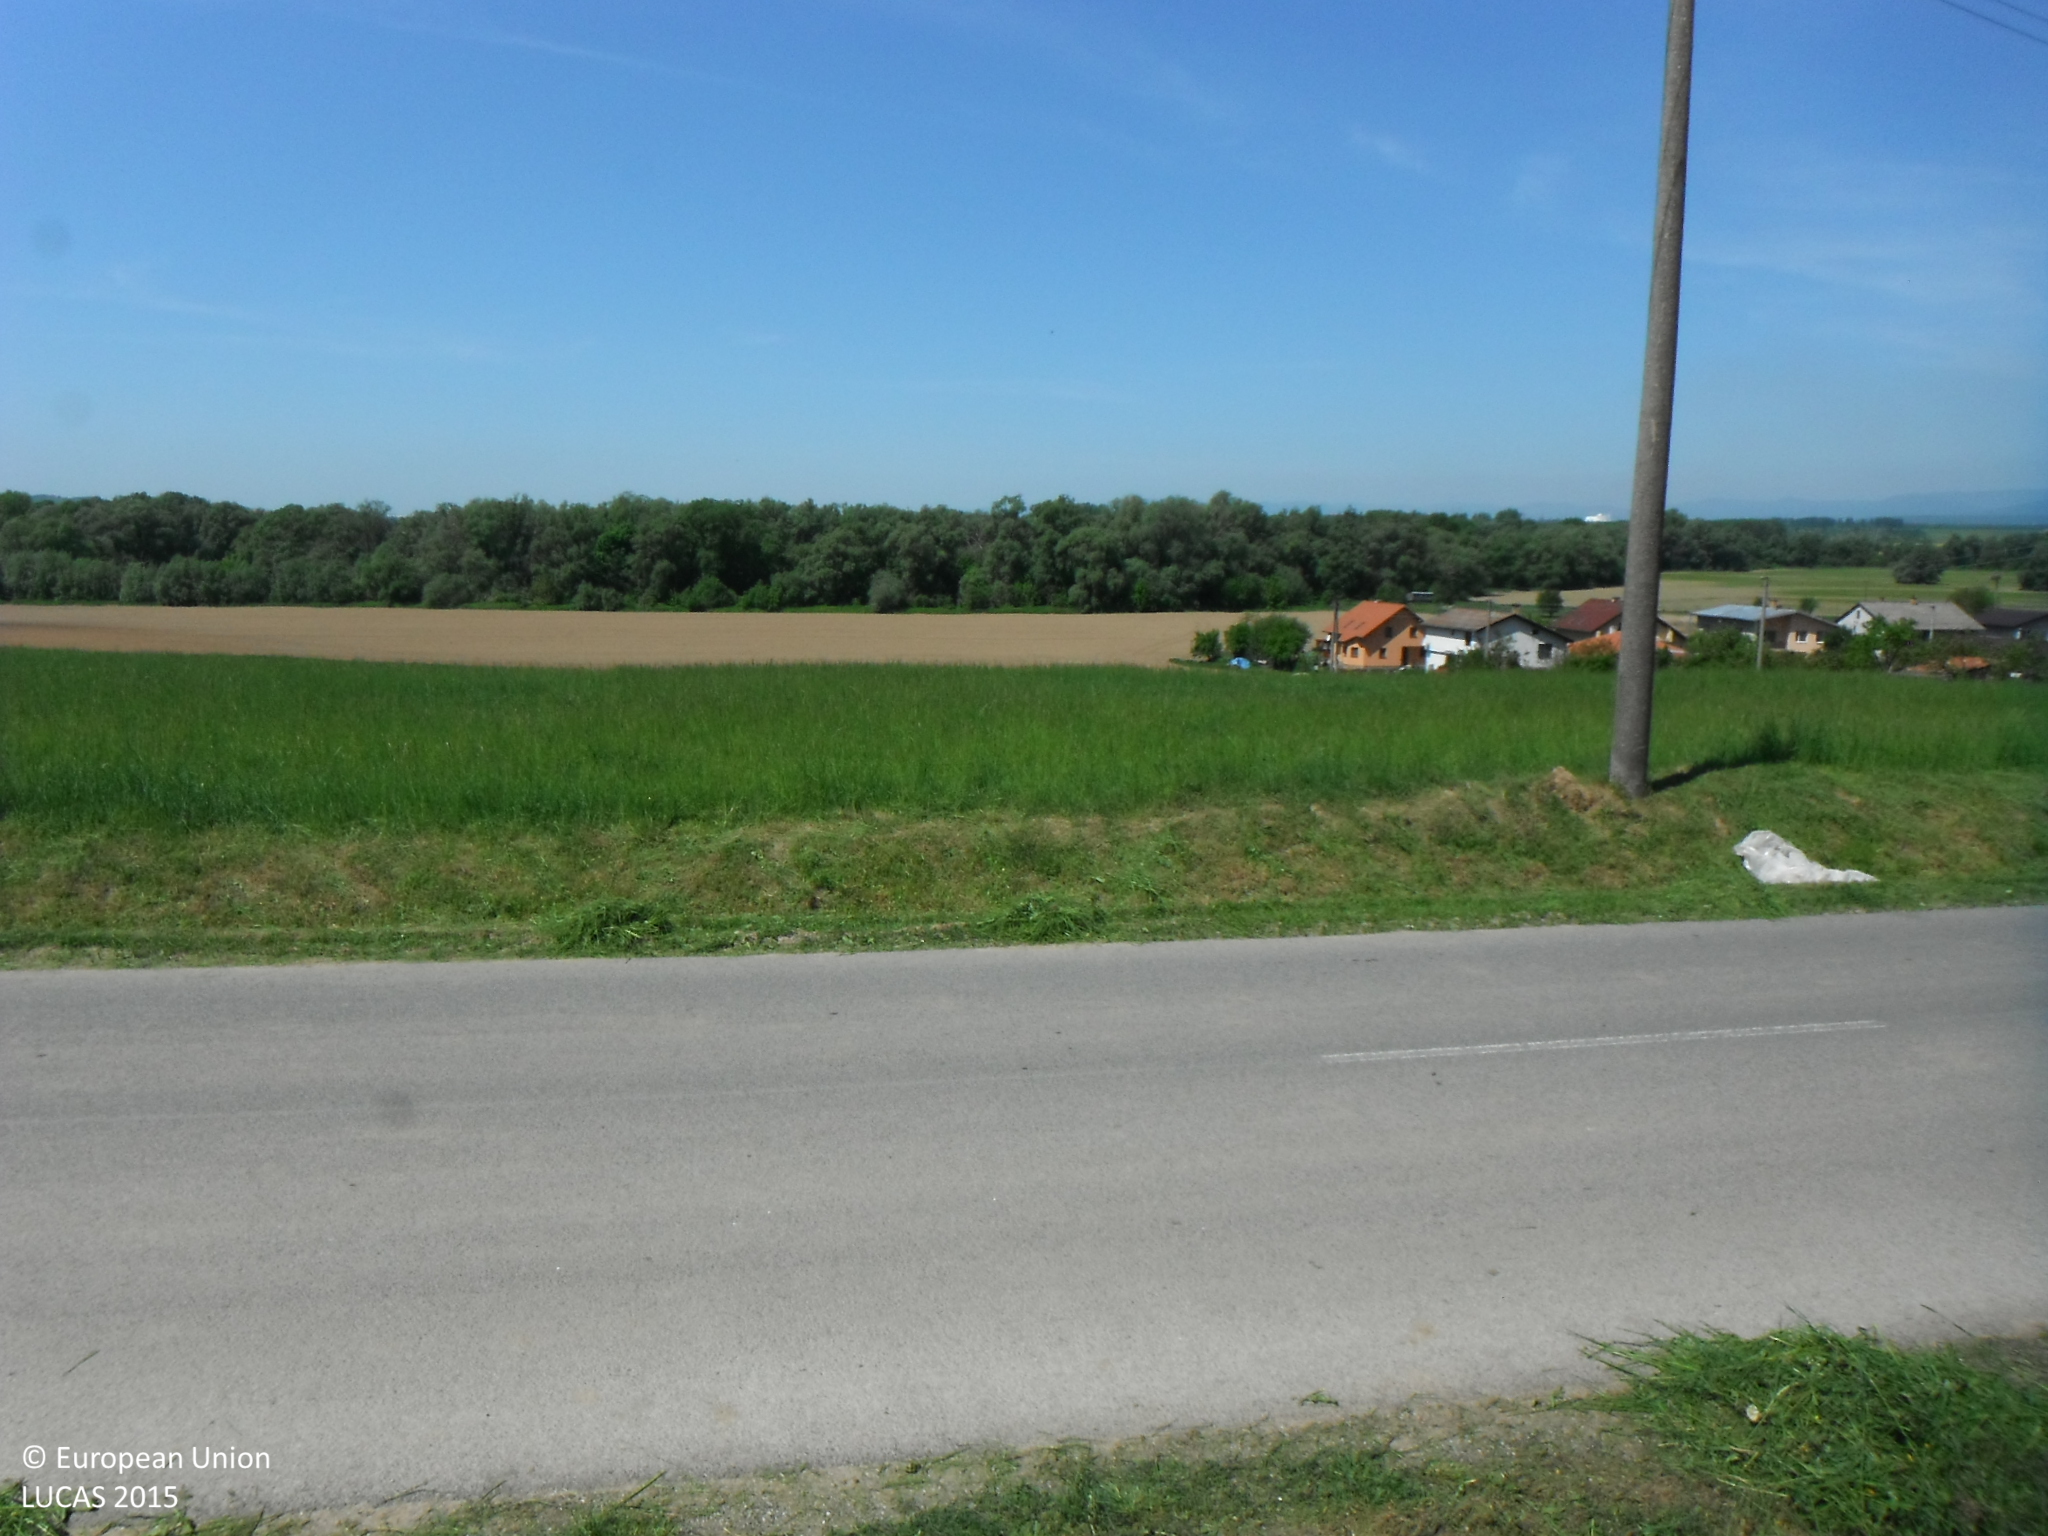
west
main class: Cropland
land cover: Maize
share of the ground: < 10 %
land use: Agriculture (excluding fallow land and kitchen gardens)
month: May
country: SK
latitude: 48.5636
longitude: 21.3328
